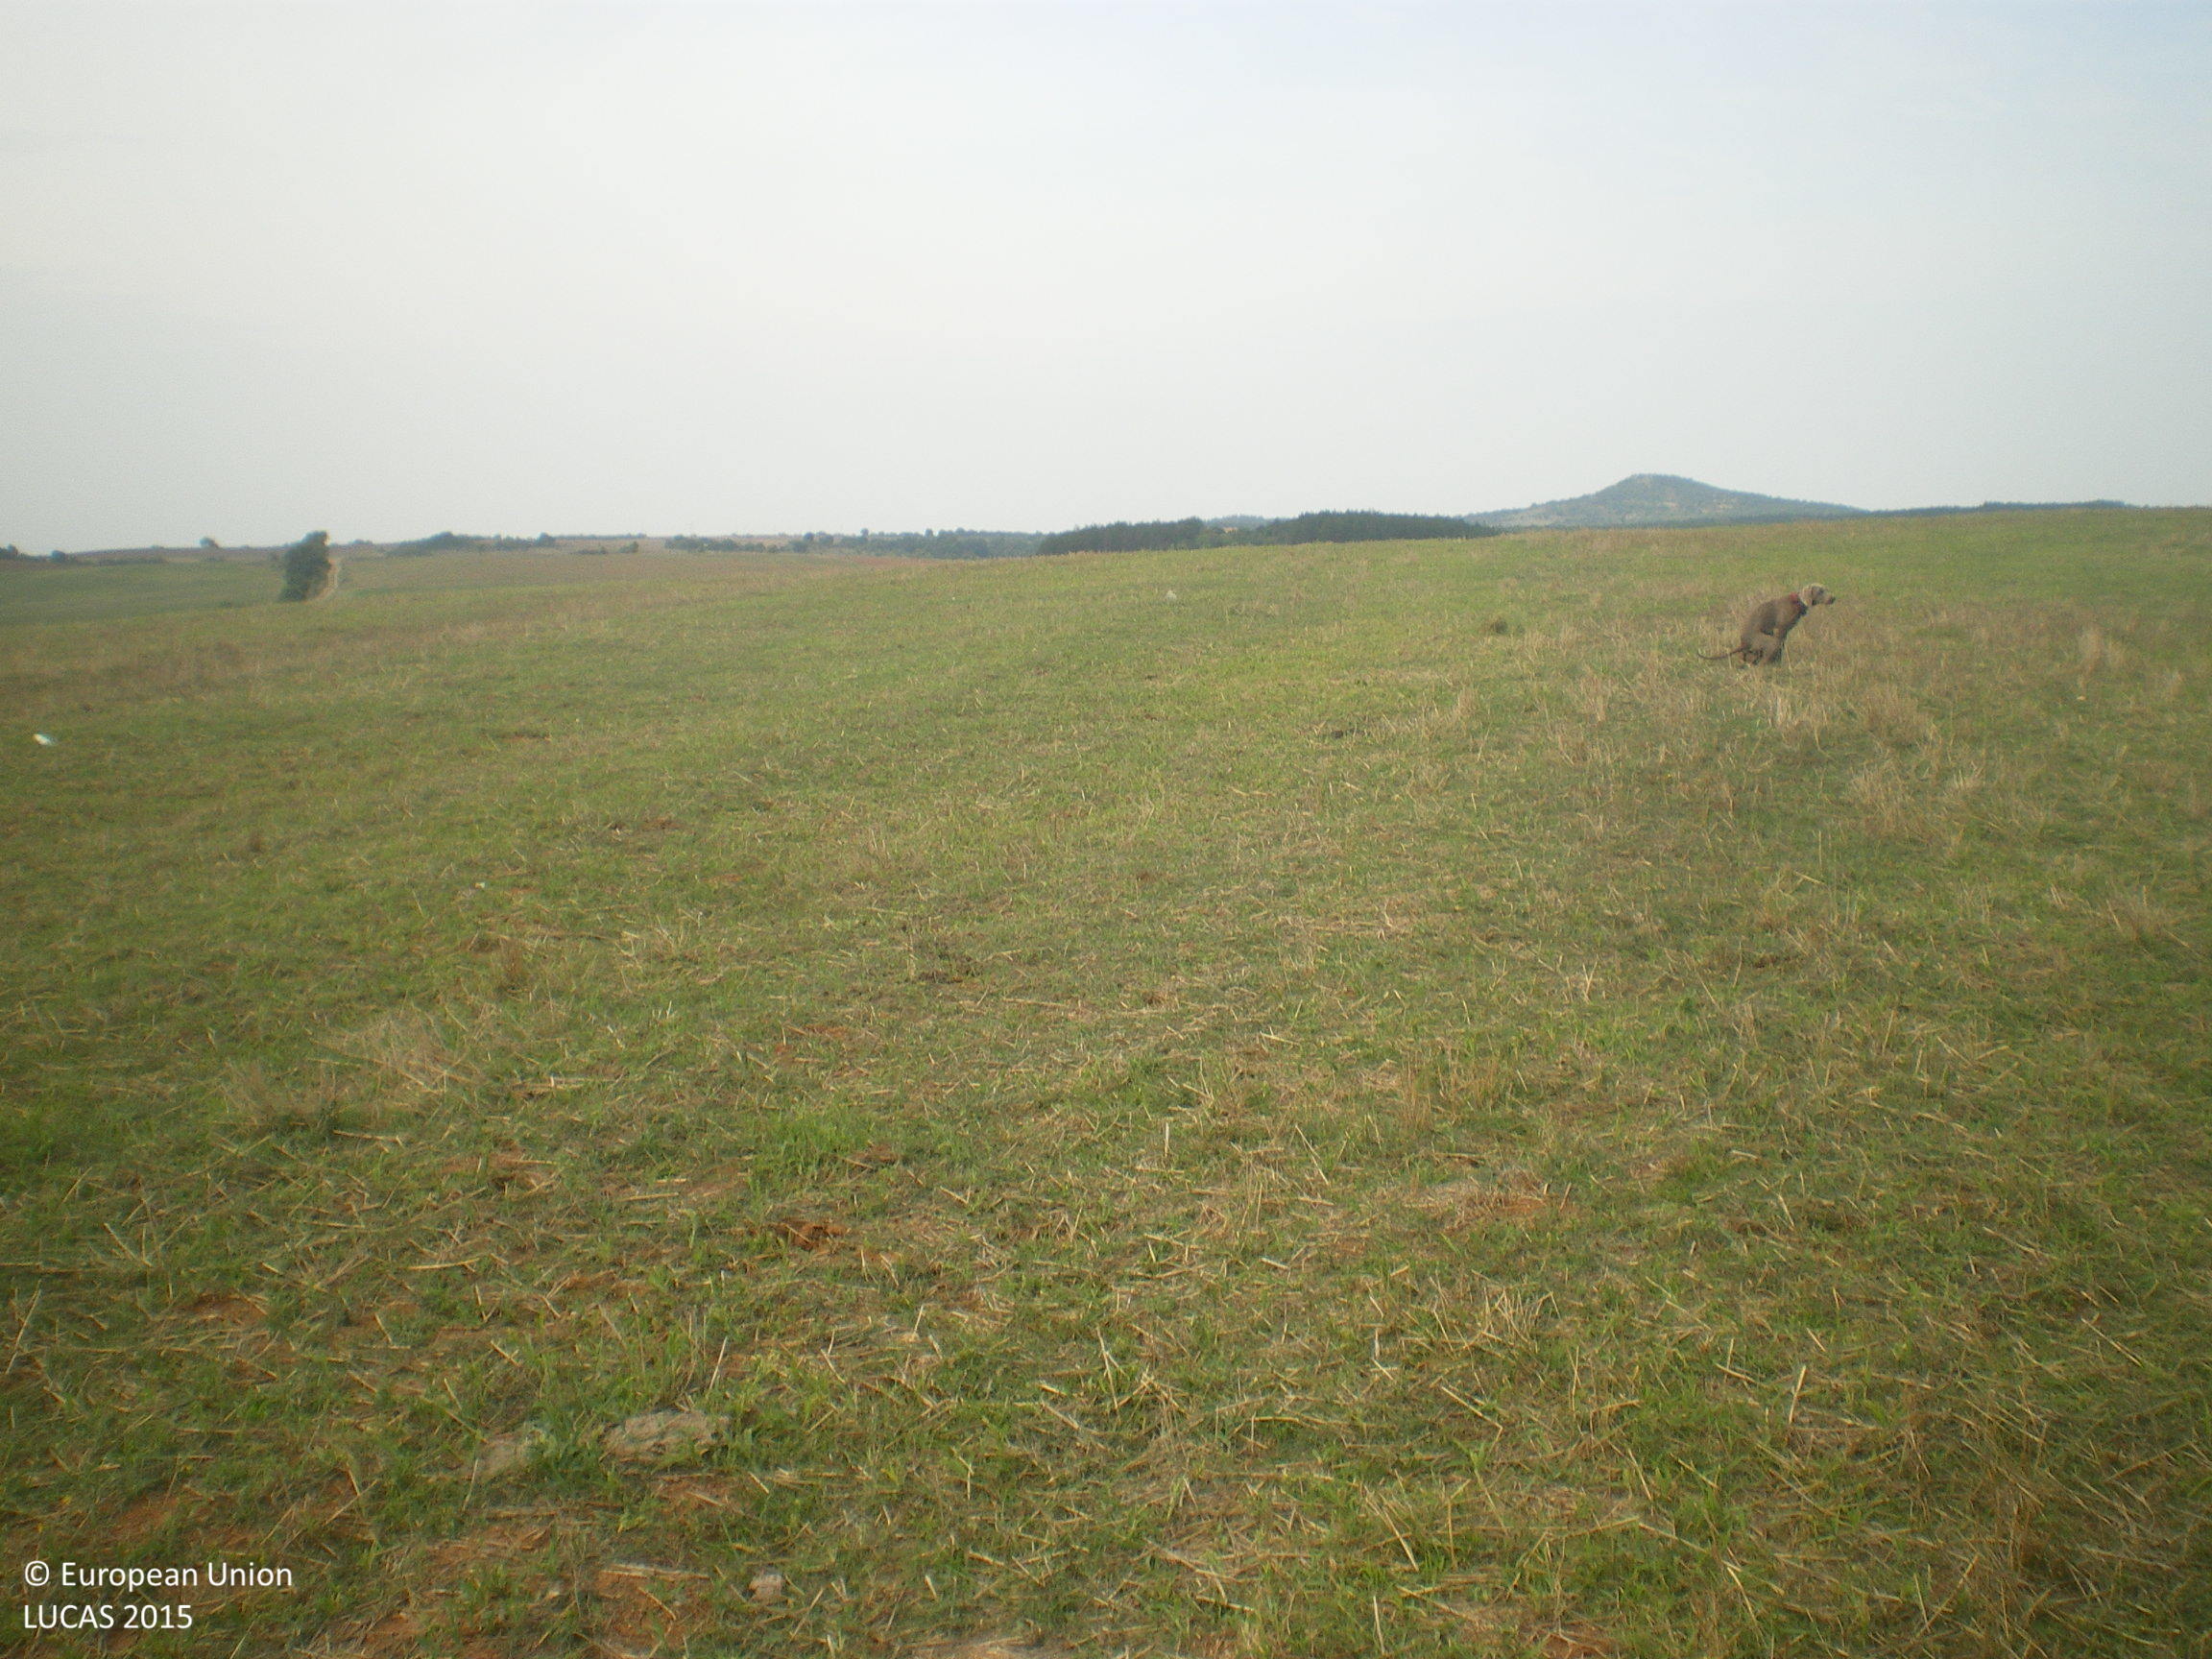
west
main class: Cropland
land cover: Common wheat
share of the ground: < 10 %
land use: Agriculture (excluding fallow land and kitchen gardens)
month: September
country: BG
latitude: 41.8819
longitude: 25.9176
